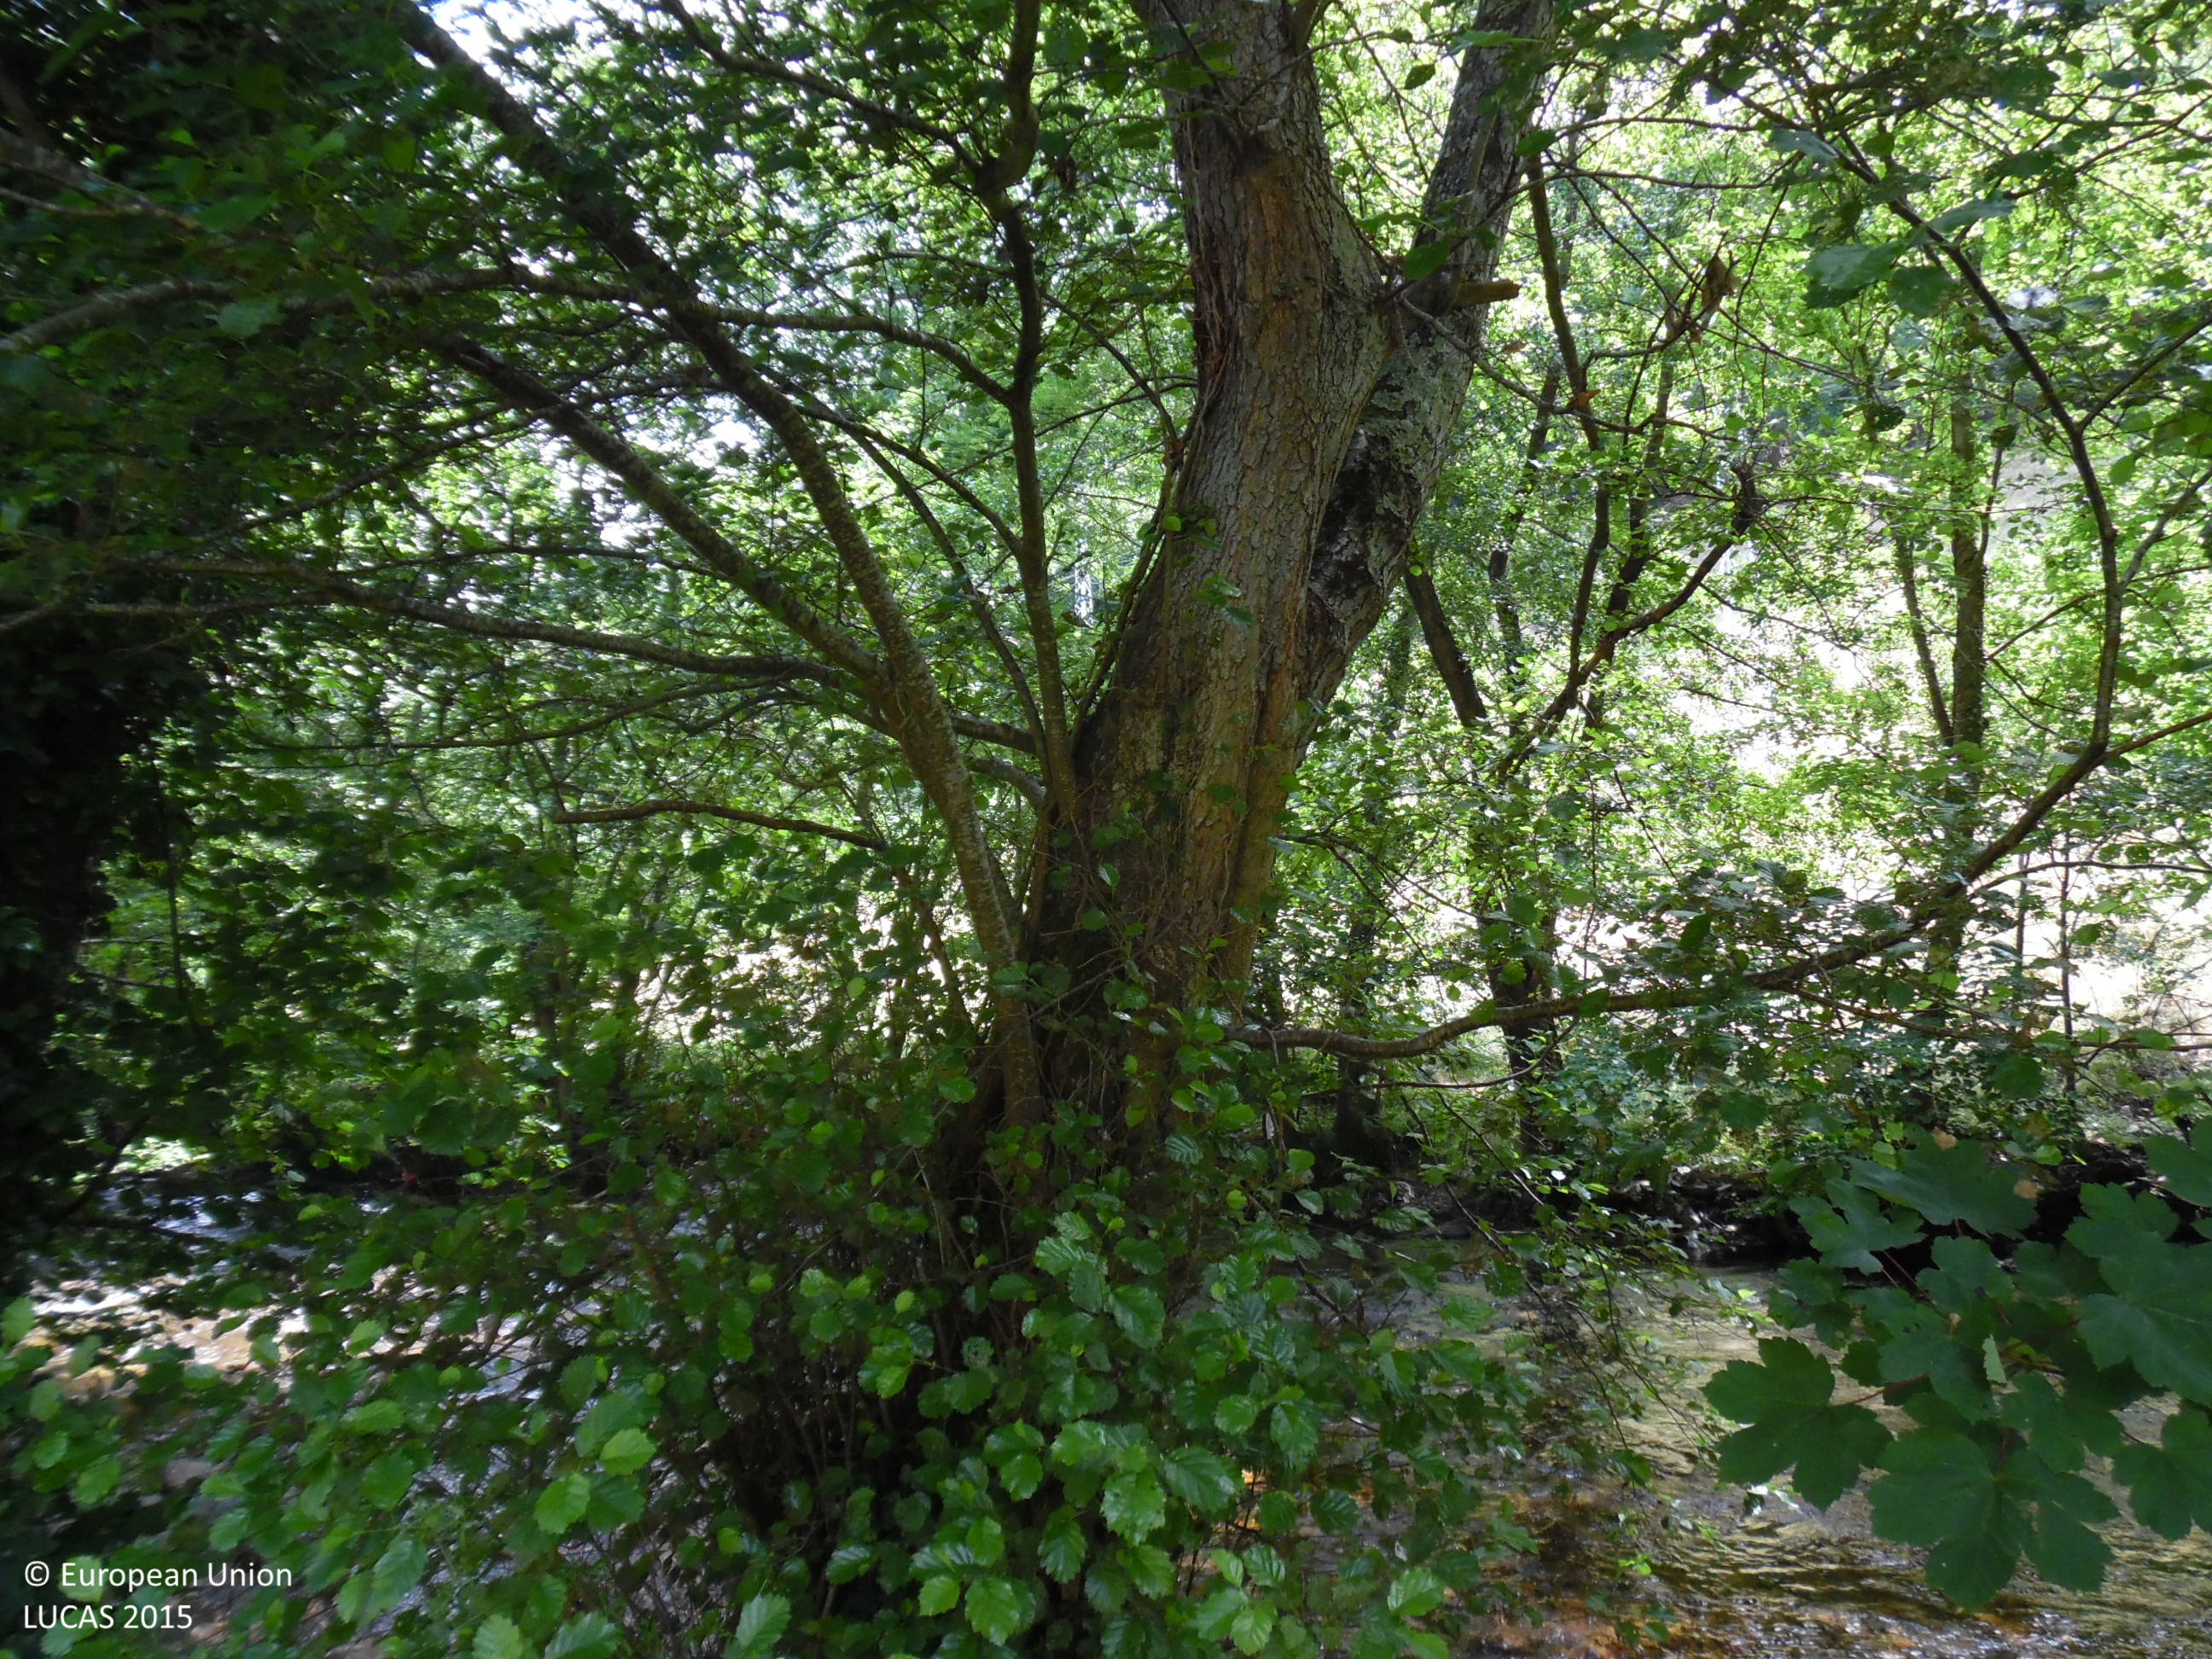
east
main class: Grassland
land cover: Grassland without tree/shrub cover
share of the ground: 25 - 50 %
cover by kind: herbaceous plants 100 %
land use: Agriculture (excluding fallow land and kitchen gardens)
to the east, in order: Grassland without tree/shrub cover; Groves; Inland fresh running water; Groves; Grassland without tree/shrub cover; Electric lines; Grassland without tree/shrub cover; Electric lines; Grassland without tree/shrub cover; Broadleaved woodland
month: July
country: ES
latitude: 43.1153
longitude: -6.5826
